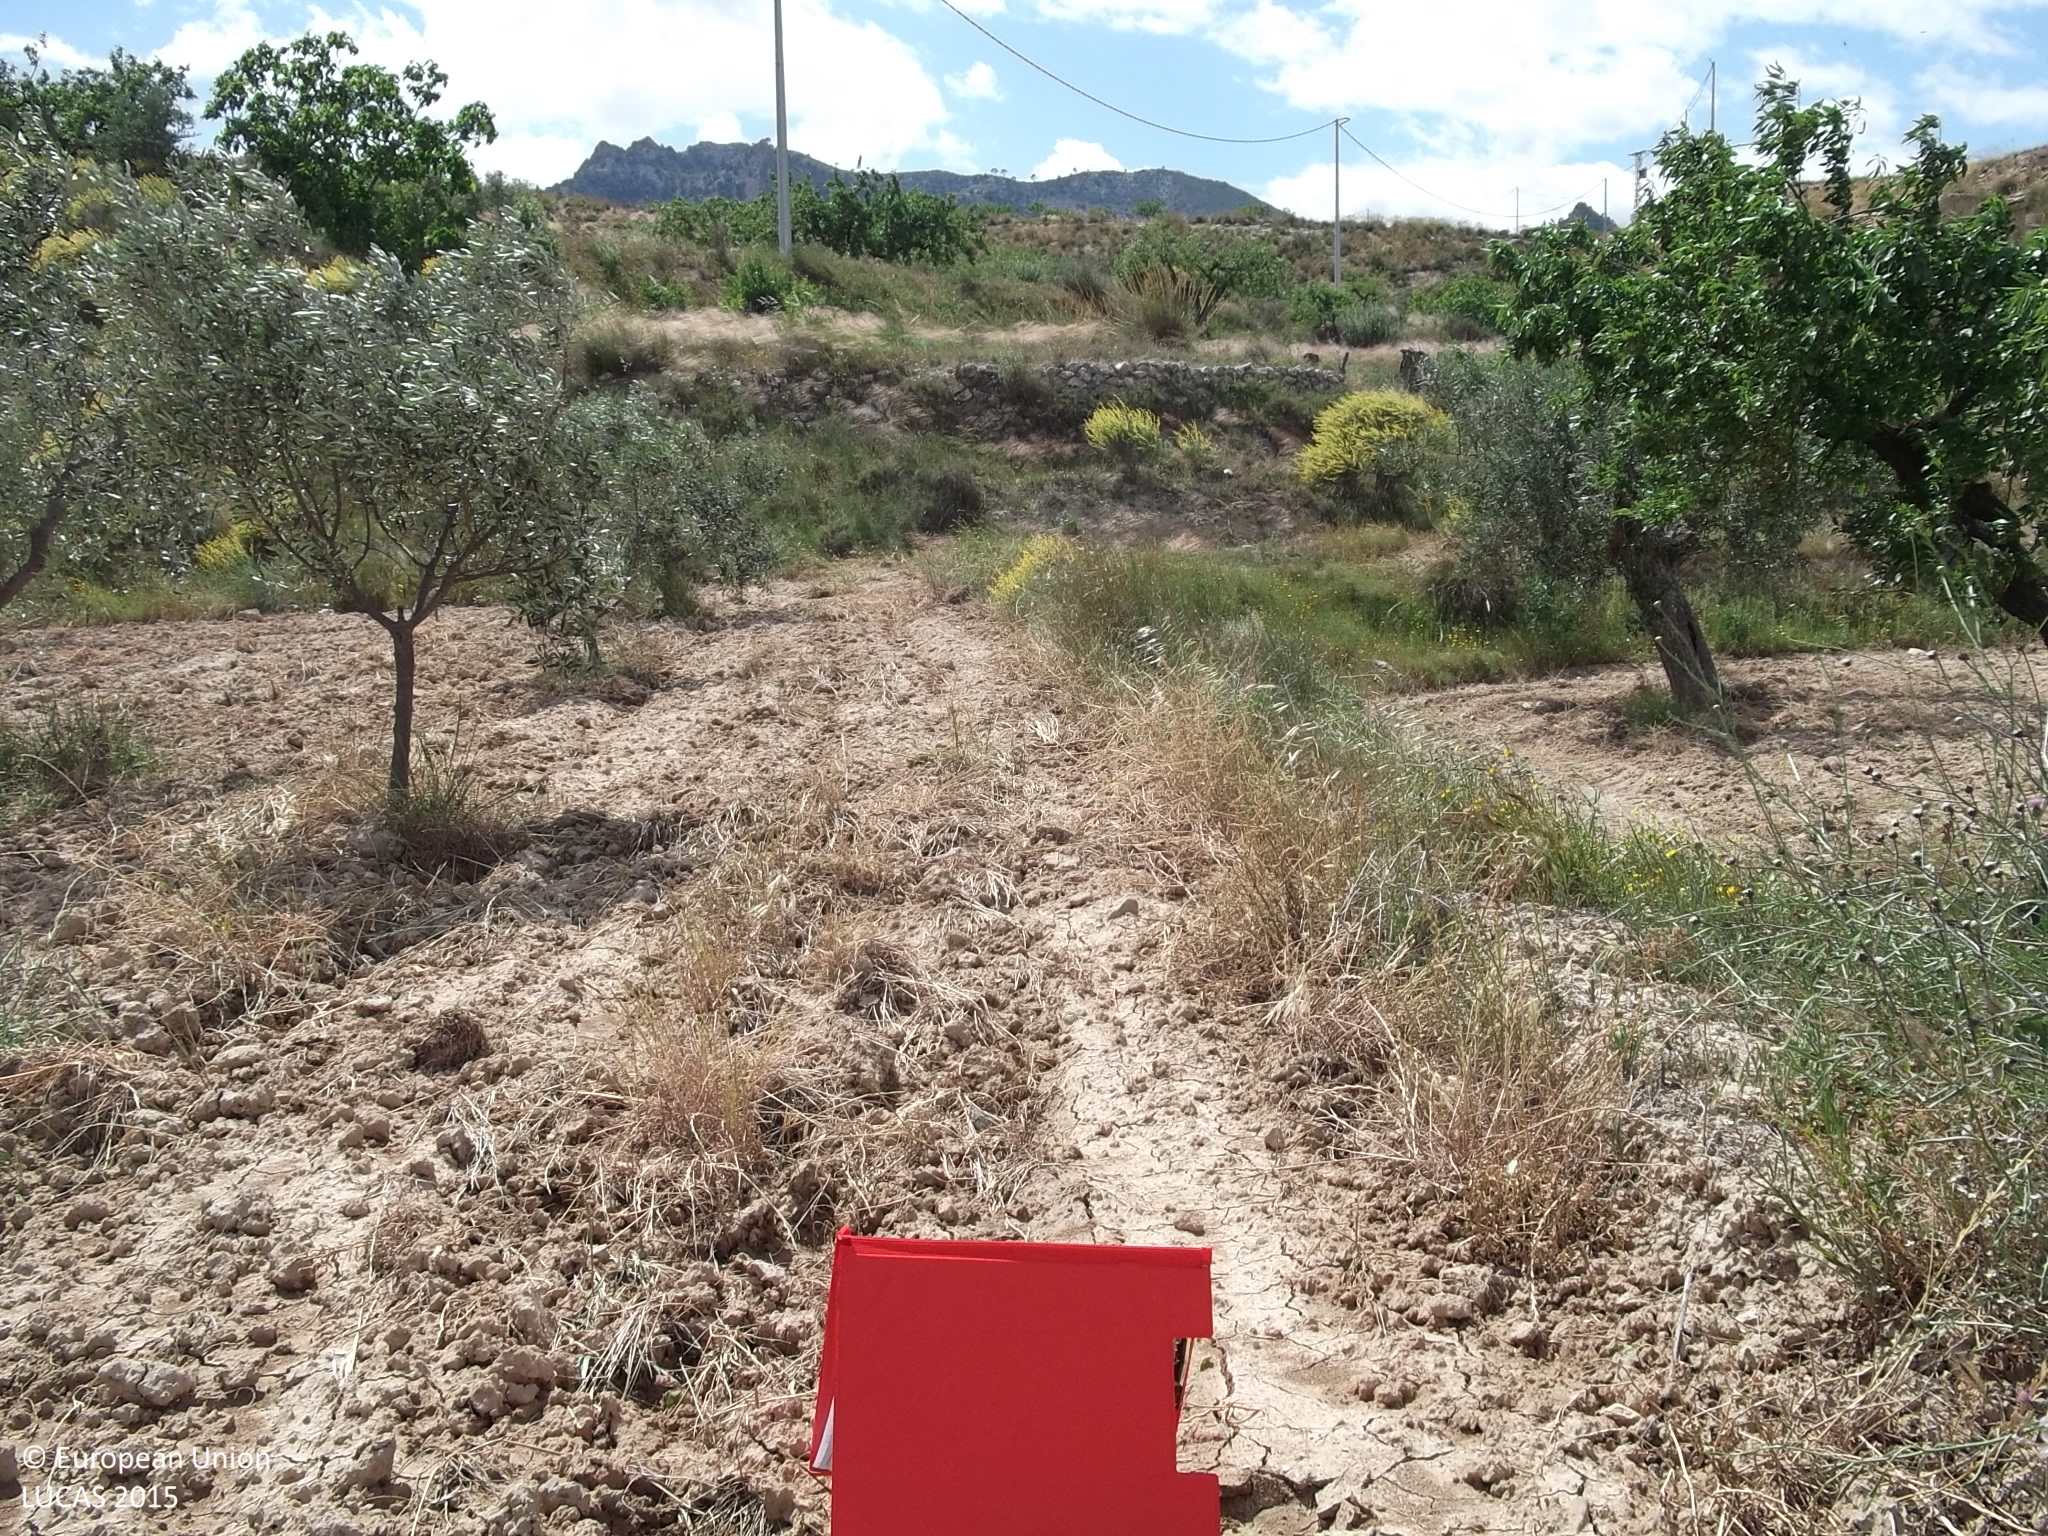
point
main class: Cropland
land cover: Olive groves
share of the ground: 10 - 25 %
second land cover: Other bare soil
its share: > 75 %
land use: Agriculture (excluding fallow land and kitchen gardens)
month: April
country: ES
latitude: 38.1586
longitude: -1.3884
